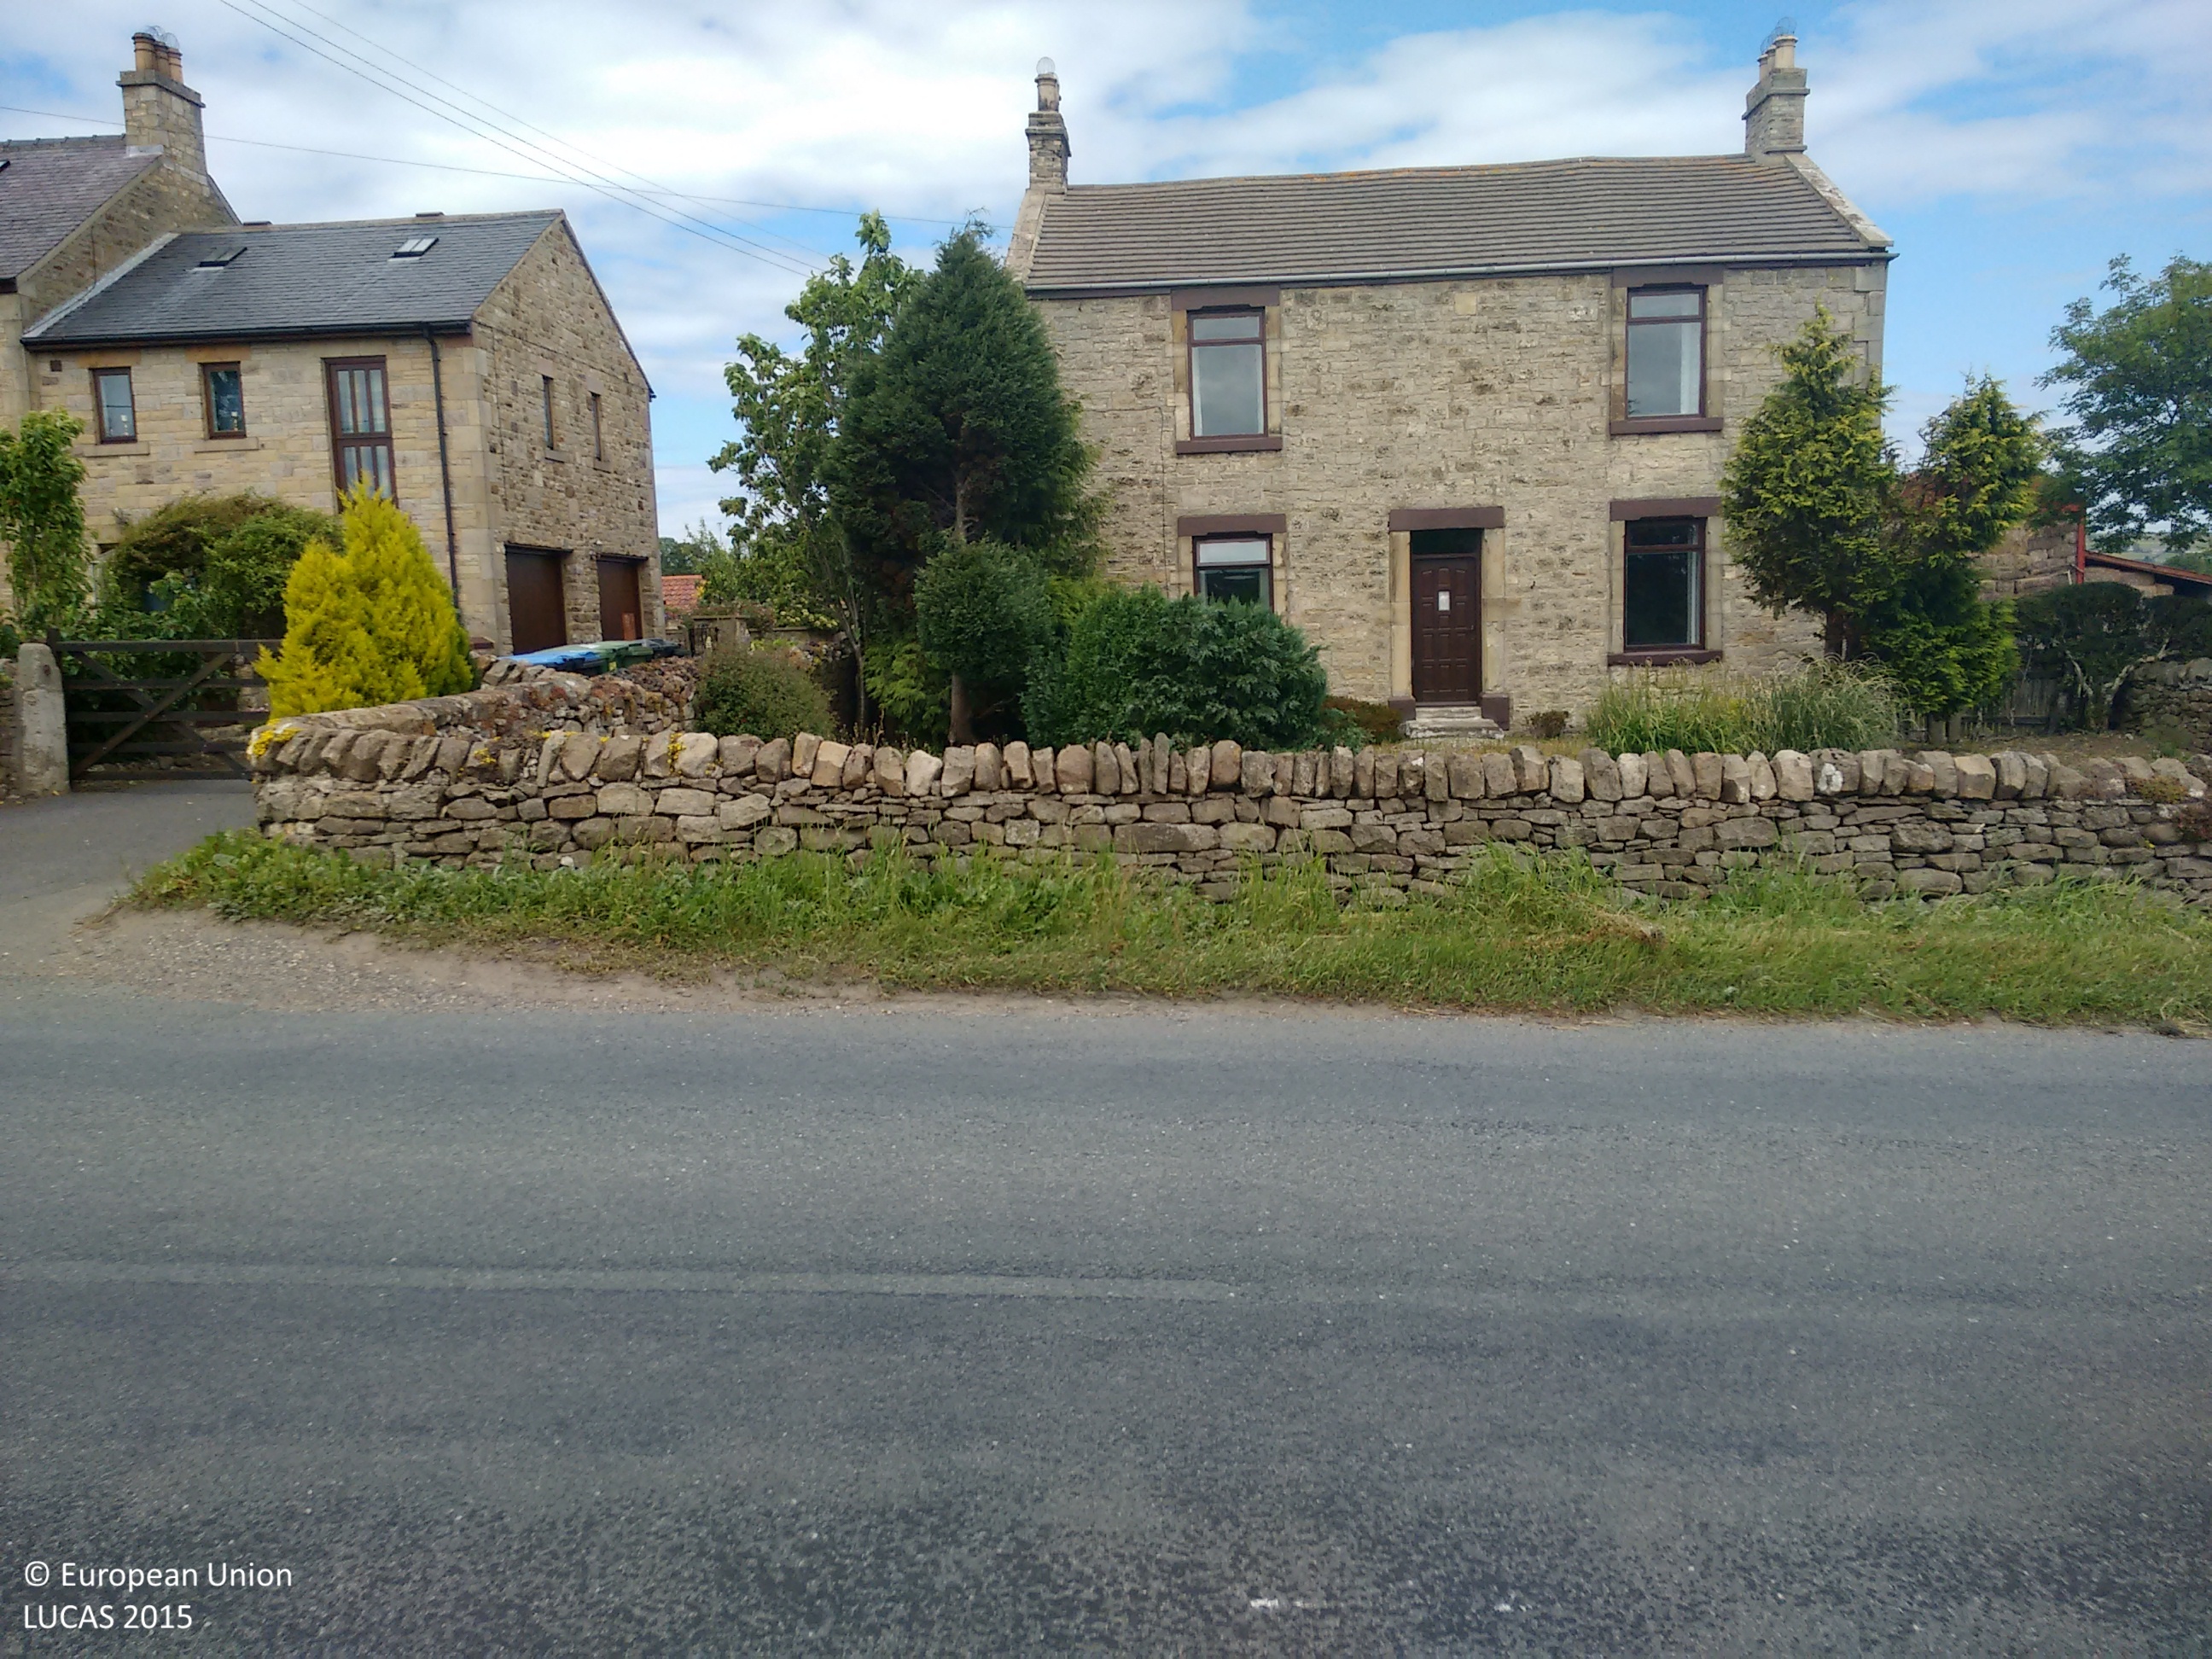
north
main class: Grassland
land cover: Grassland without tree/shrub cover
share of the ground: > 75 %
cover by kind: herbaceous plants 100 %
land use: Agriculture (excluding fallow land and kitchen gardens)
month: June
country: GB
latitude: 54.6984
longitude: -1.7670
